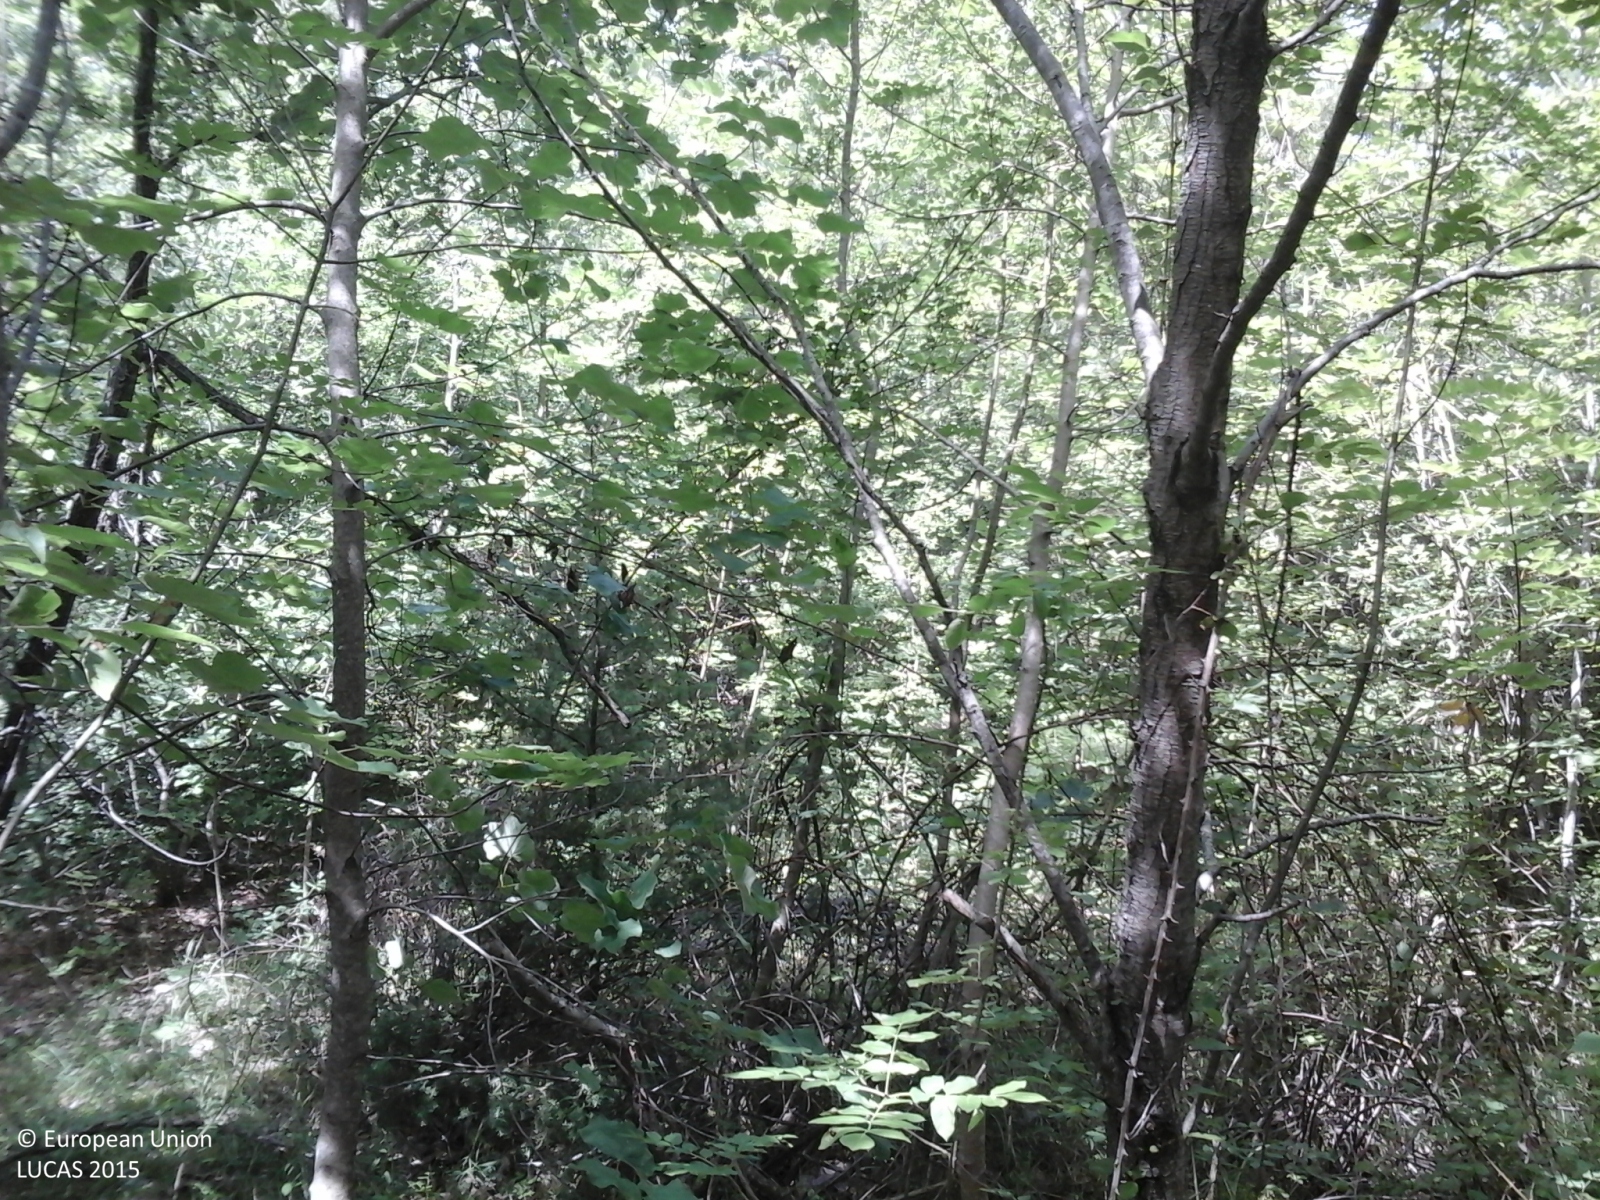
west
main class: Woodland
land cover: Pine dominated mixed woodland
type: thermophilous deciduous forest
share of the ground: > 75 %
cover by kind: broadleaved forest trees 60 %, coniferous forest trees 40 %
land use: Forestry
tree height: > 5 m
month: June
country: IT
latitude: 42.8662
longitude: 13.4541
